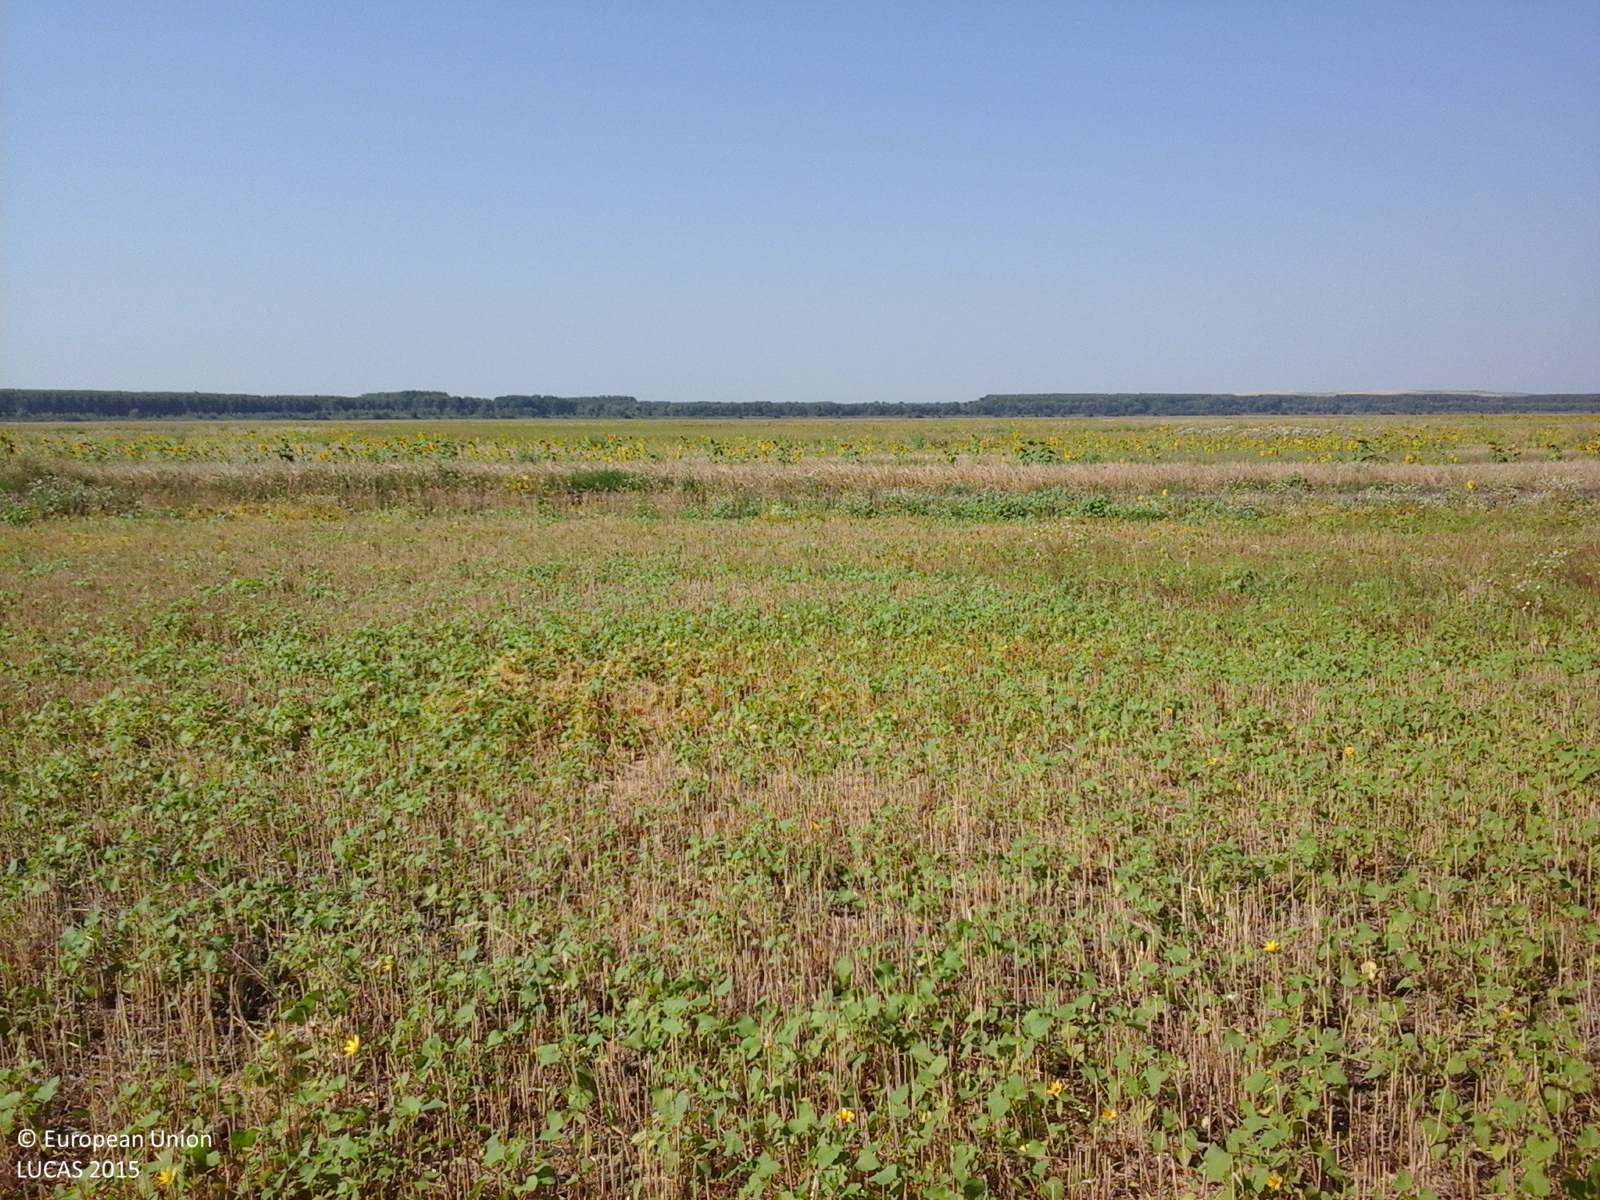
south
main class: Cropland
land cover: Common wheat
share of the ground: > 75 %
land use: Agriculture (excluding fallow land and kitchen gardens)
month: July
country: RO
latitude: 44.2713
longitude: 27.9046
